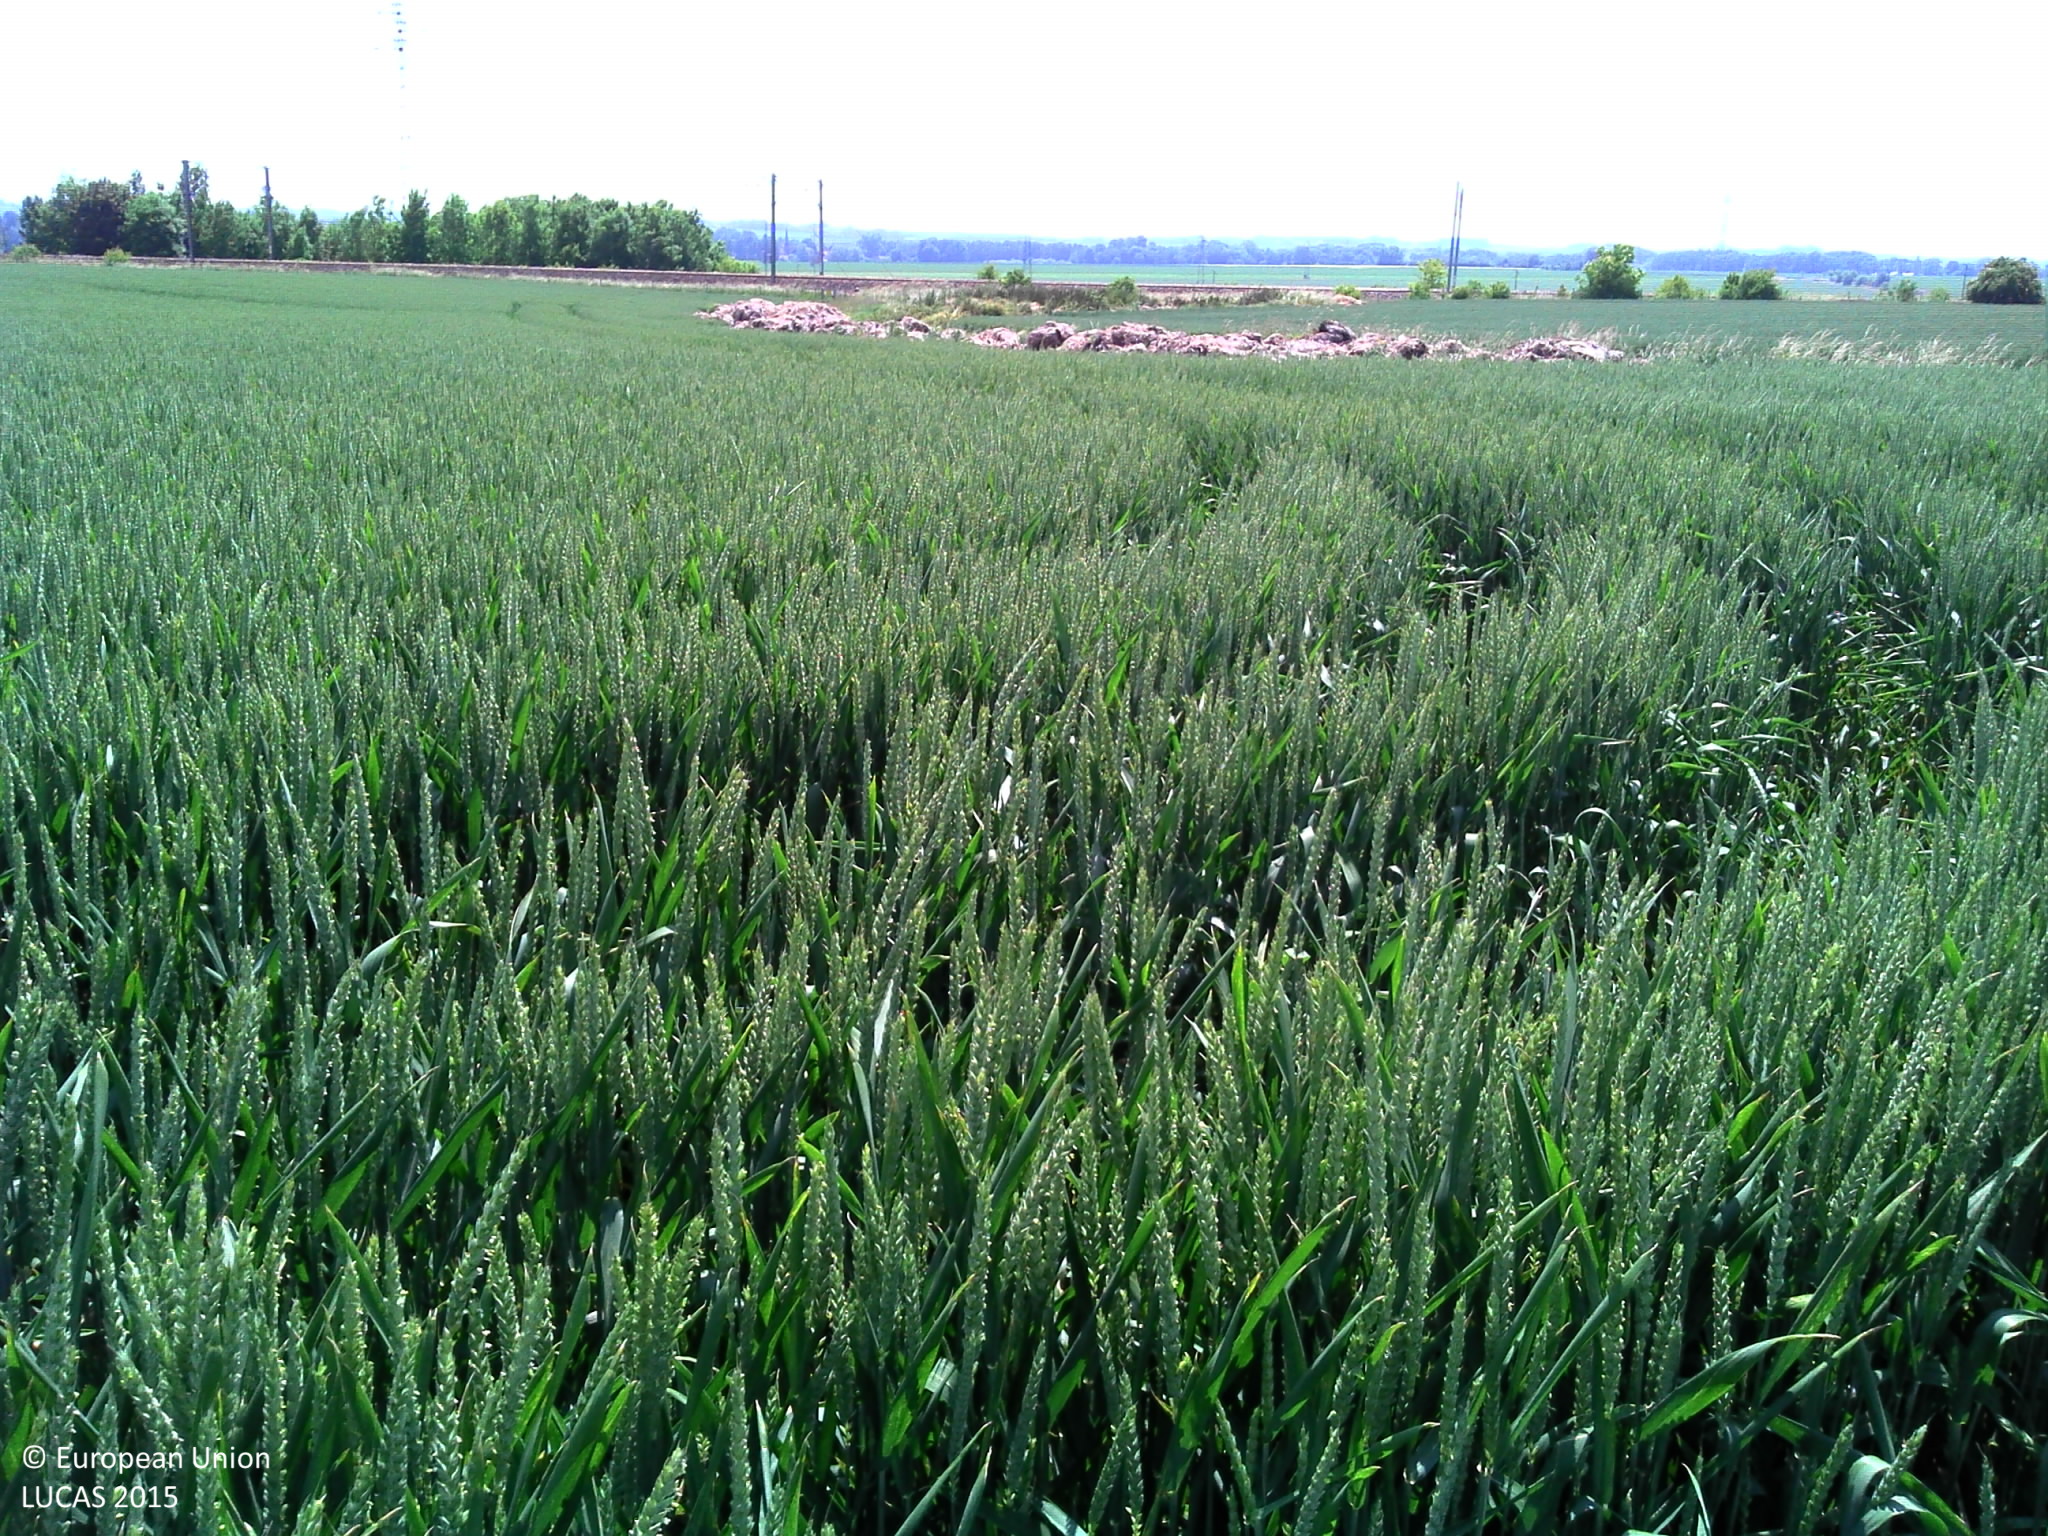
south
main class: Cropland
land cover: Common wheat
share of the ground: > 75 %
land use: Agriculture (excluding fallow land and kitchen gardens)
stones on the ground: < 10 %
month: June
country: FR
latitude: 50.2272
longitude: 2.7981
